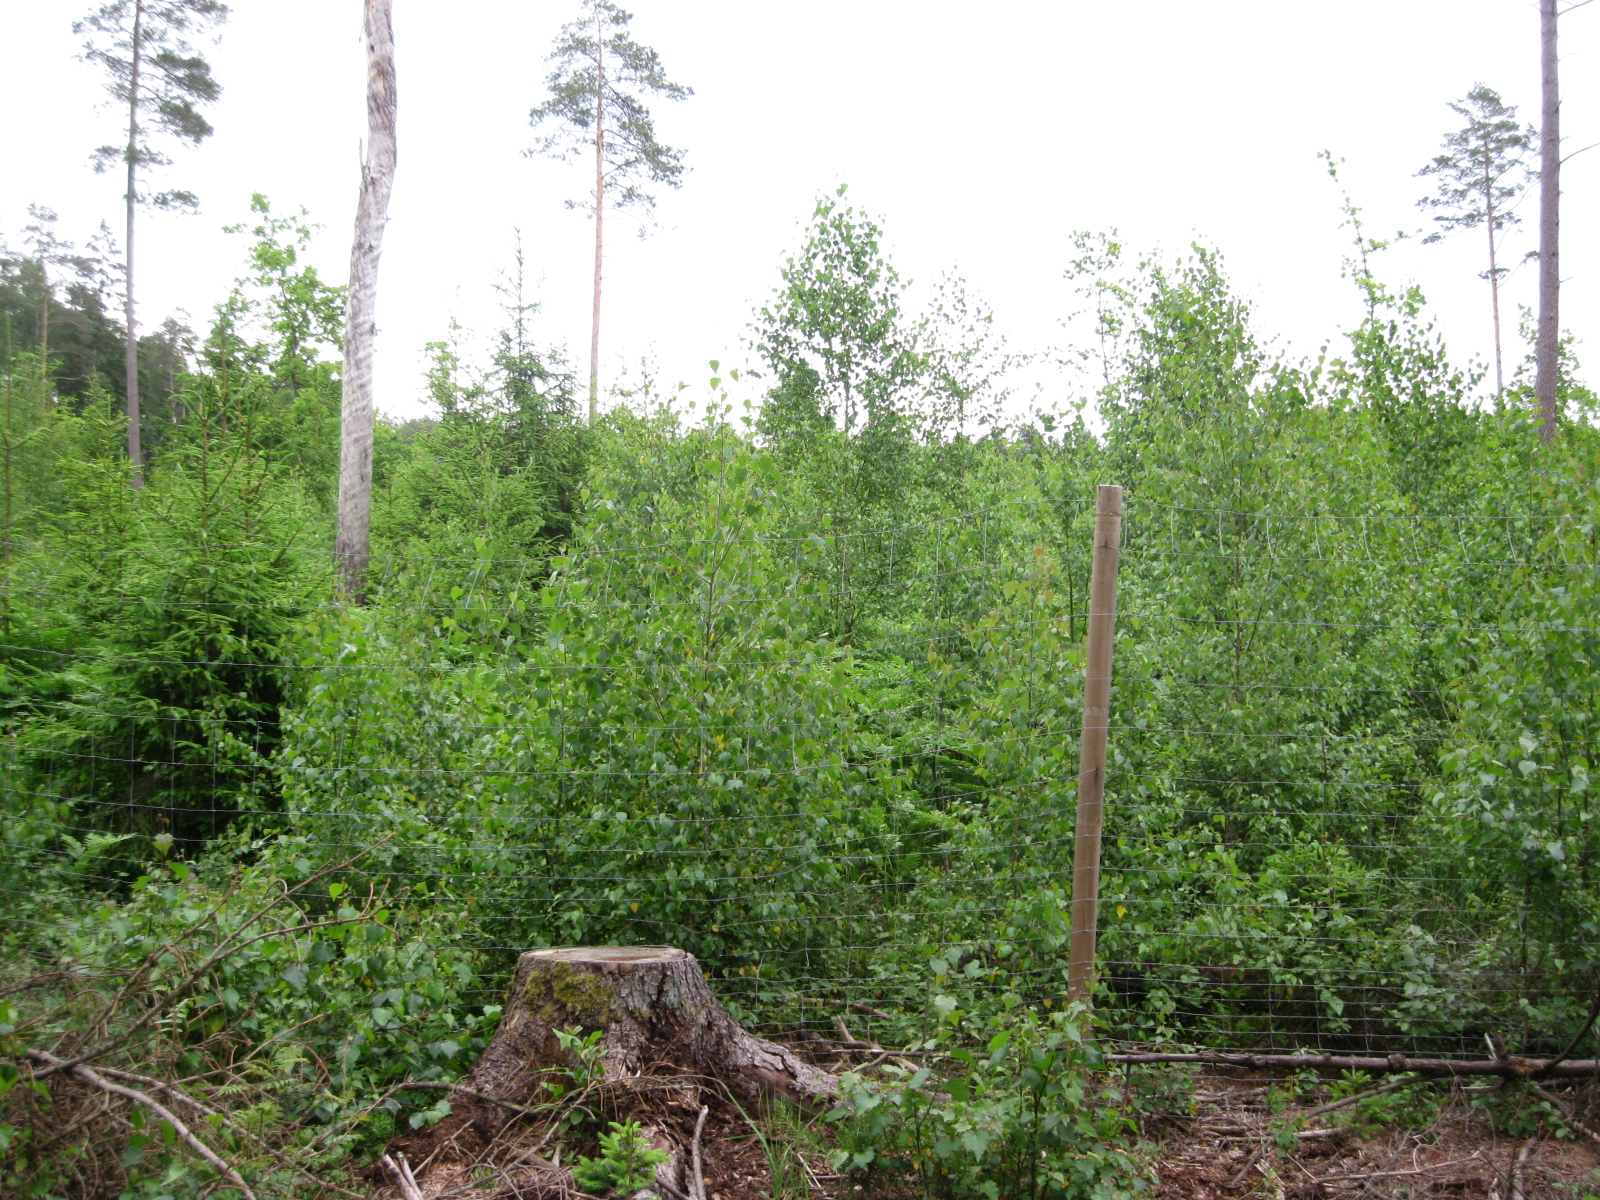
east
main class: Woodland
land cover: Other coniferous woodland
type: hemiboreal forest and nemoral coniferous forest and mixed broadleaved-coniferous forest
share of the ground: 50 - 75 %
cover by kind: coniferous forest trees 50 %, herbaceous plants 20 %, broadleaved forest trees 10 %, shrubs 10 %, unconsolidated bare surface 10 %
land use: Forestry
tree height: > 5 m
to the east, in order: Other coniferous woodland; Fences; Spruce dominated mixed woodland; Fences; Other mixed woodland; Paved roads, cycling and walking lanes; Spontaneously vegetated surfaces; Ditches and canals; Spruce dominated mixed woodland
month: June
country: LT
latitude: 55.5409
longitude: 24.1810
